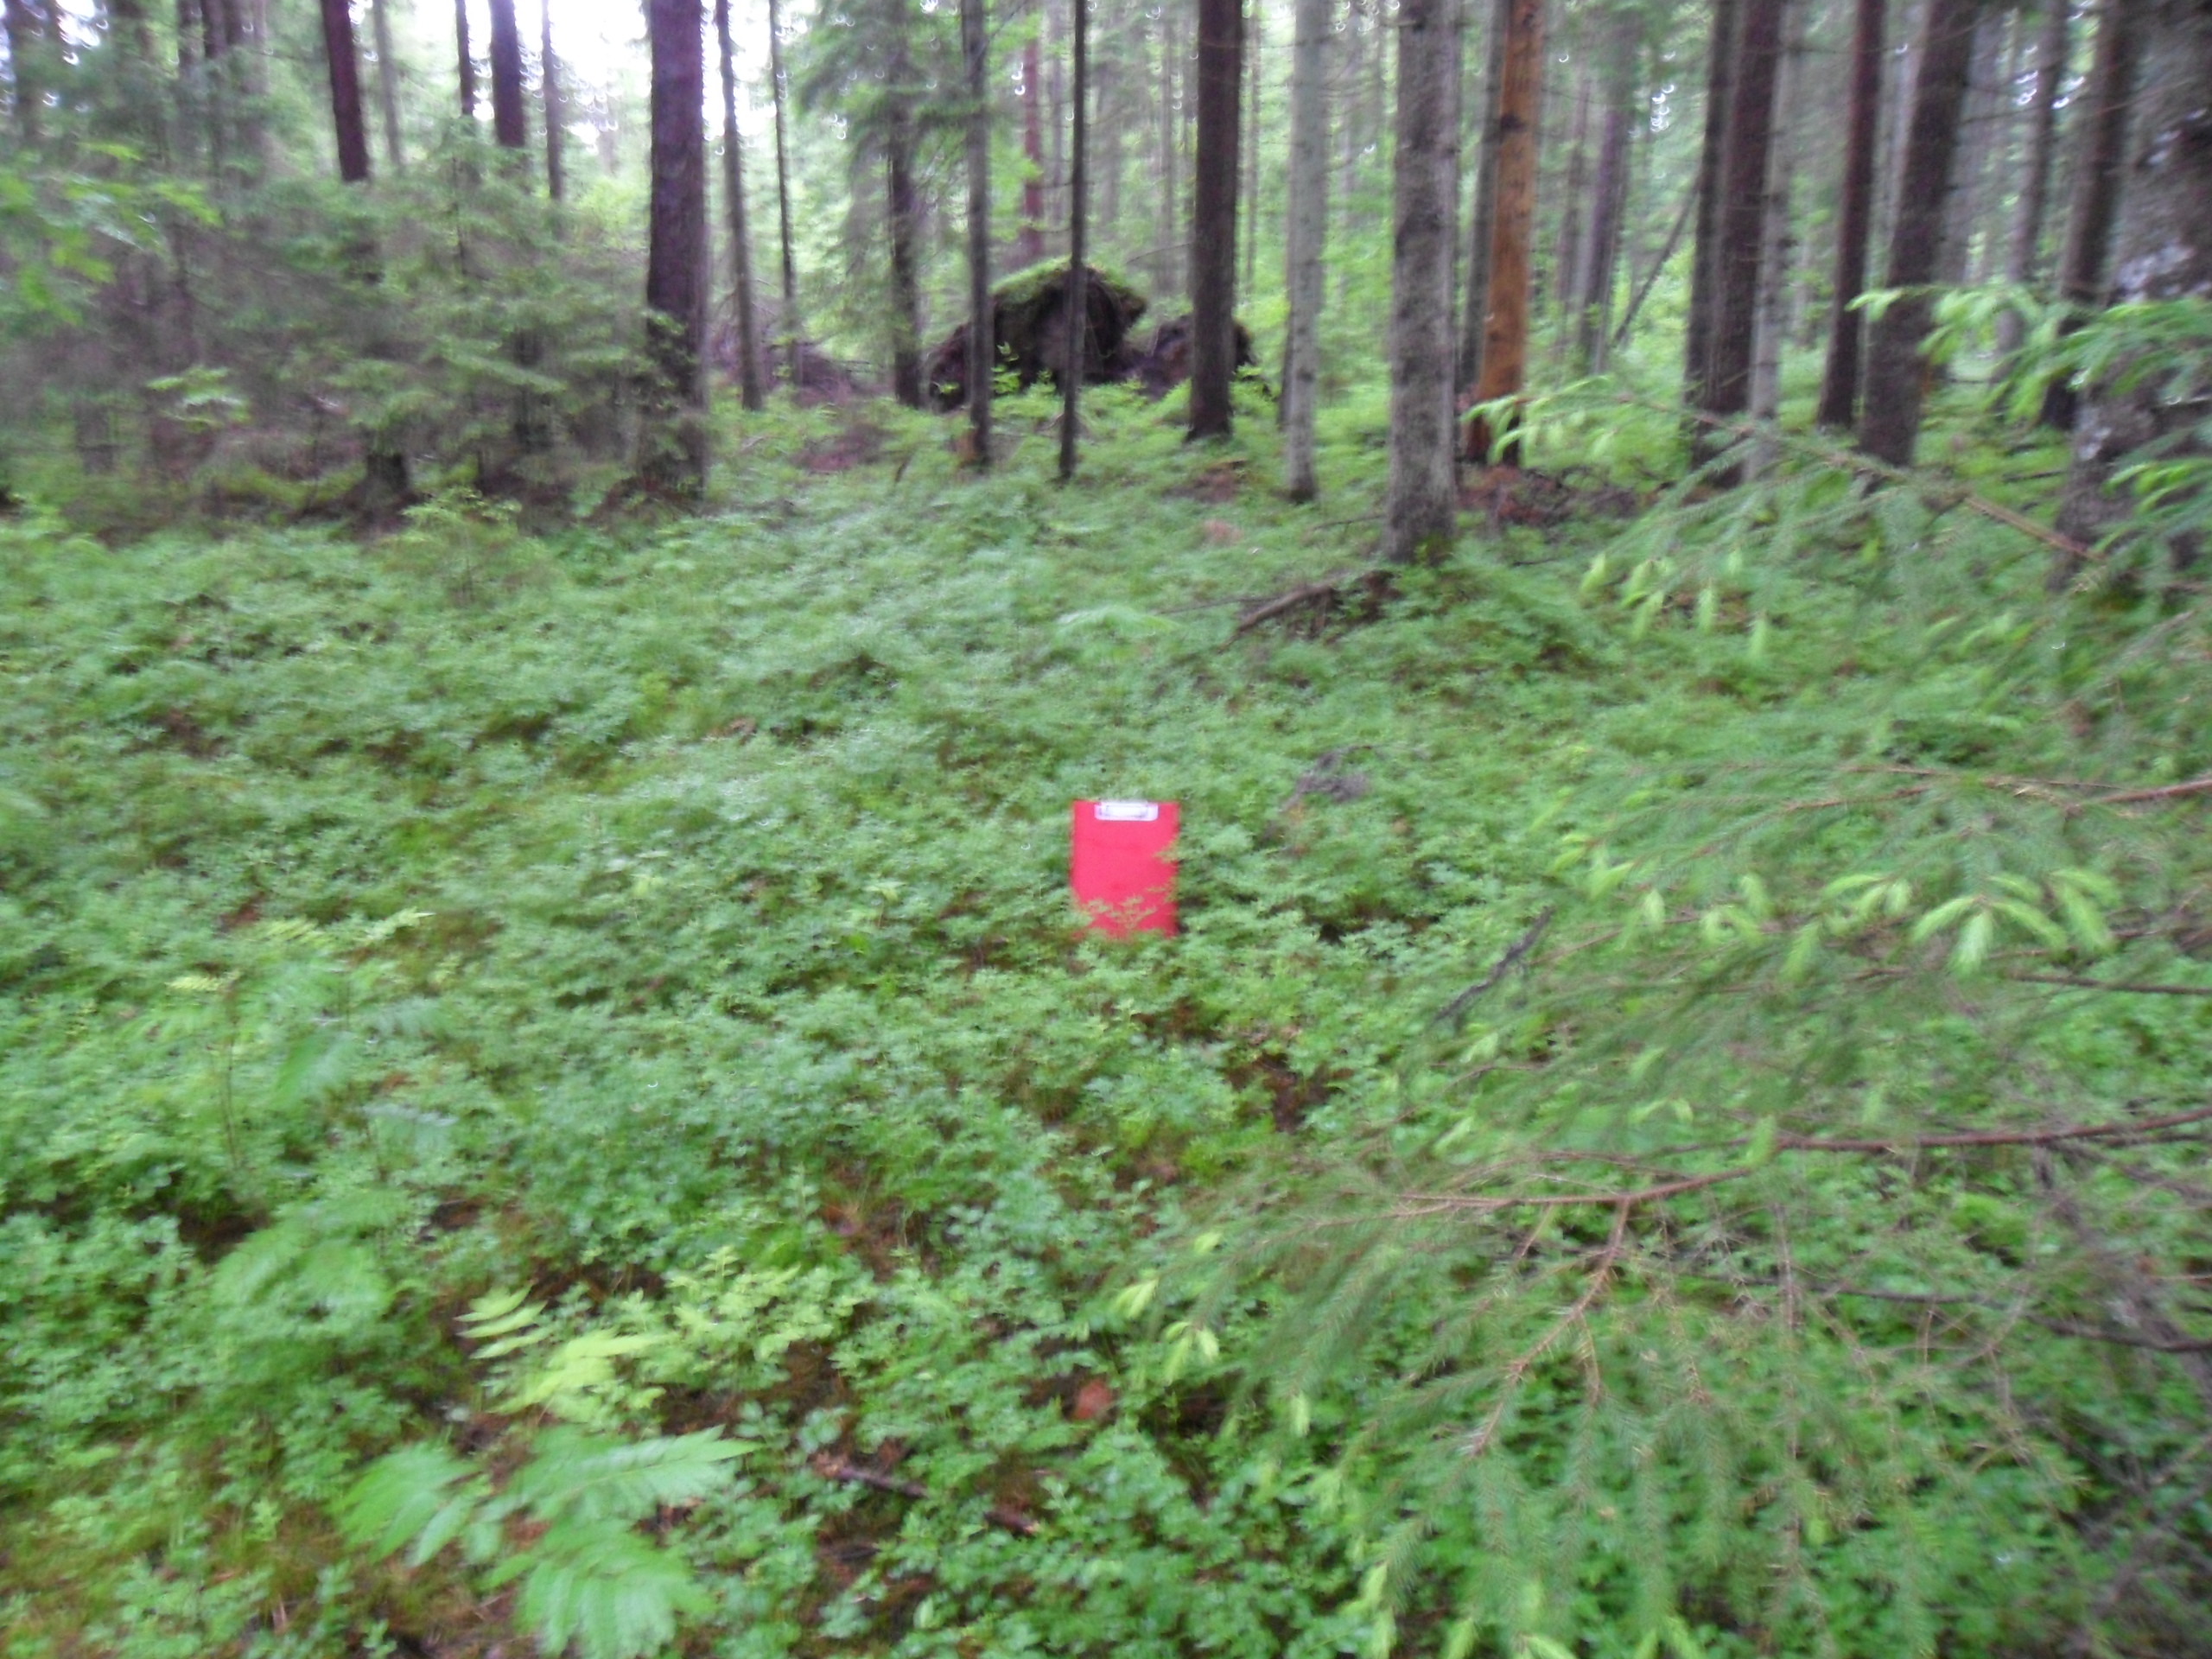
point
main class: Woodland
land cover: Other coniferous woodland
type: hemiboreal forest and nemoral coniferous forest and mixed broadleaved-coniferous forest
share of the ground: 50 - 75 %
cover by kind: coniferous forest trees 70 %, herbaceous plants 30 %
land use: Forestry
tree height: > 5 m
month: June
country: LV
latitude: 57.4555
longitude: 21.8601
